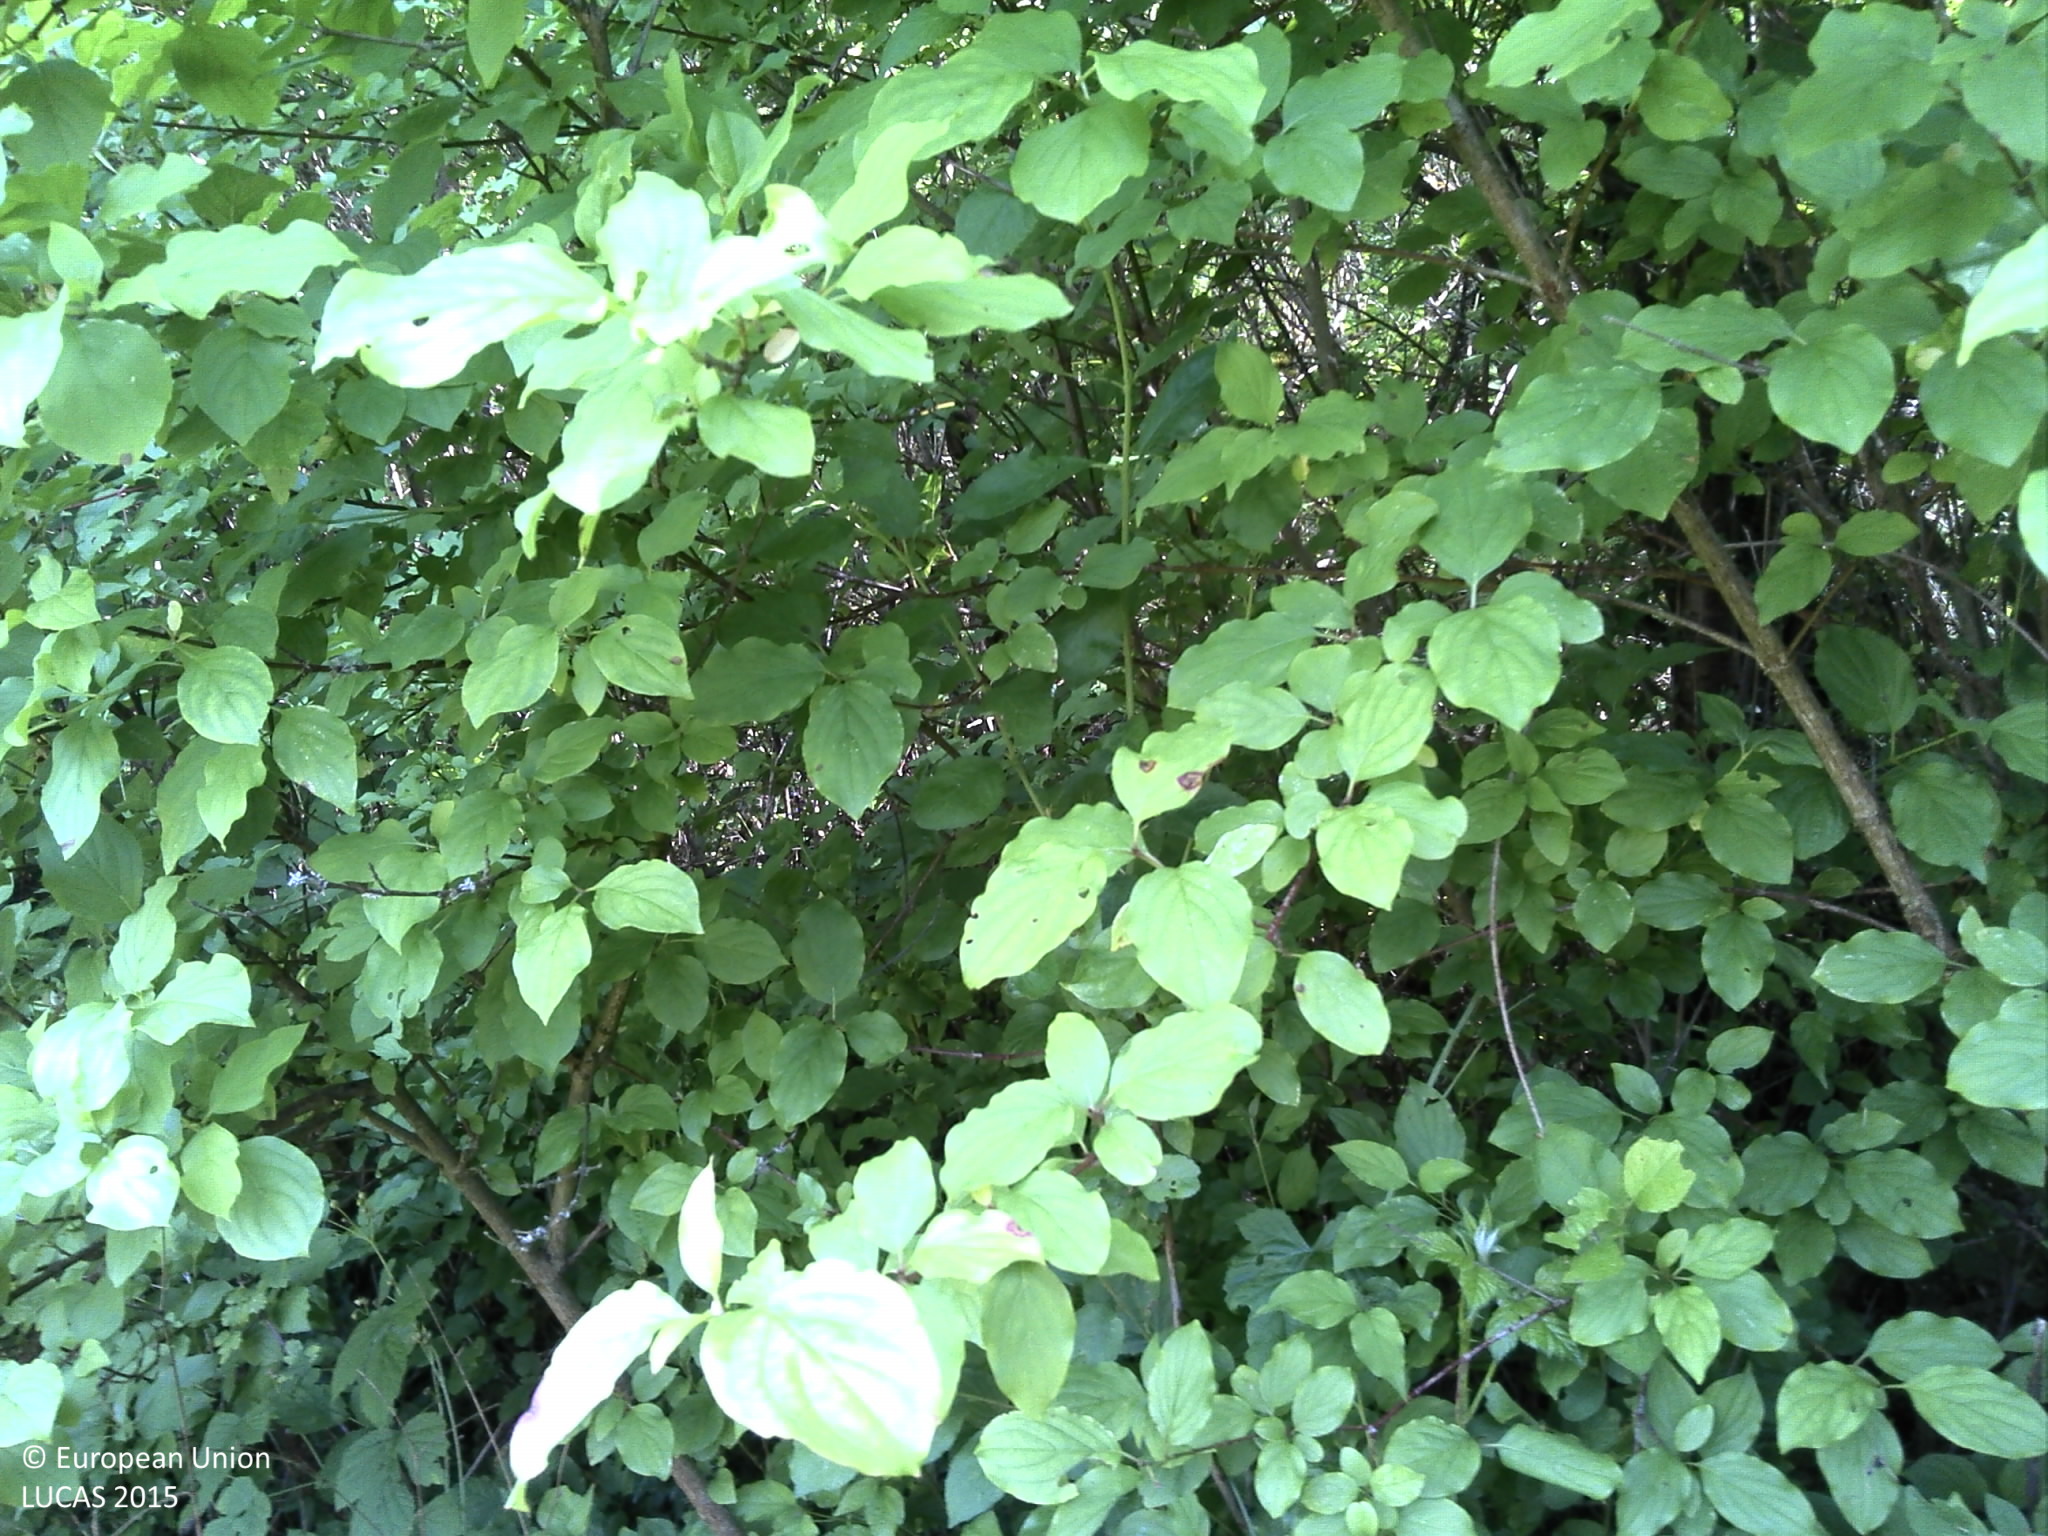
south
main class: Grassland
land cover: Grassland without tree/shrub cover
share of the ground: > 75 %
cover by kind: herbaceous plants 100 %
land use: Agriculture (excluding fallow land and kitchen gardens)
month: June
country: FR
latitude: 49.0363
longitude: 6.0738
